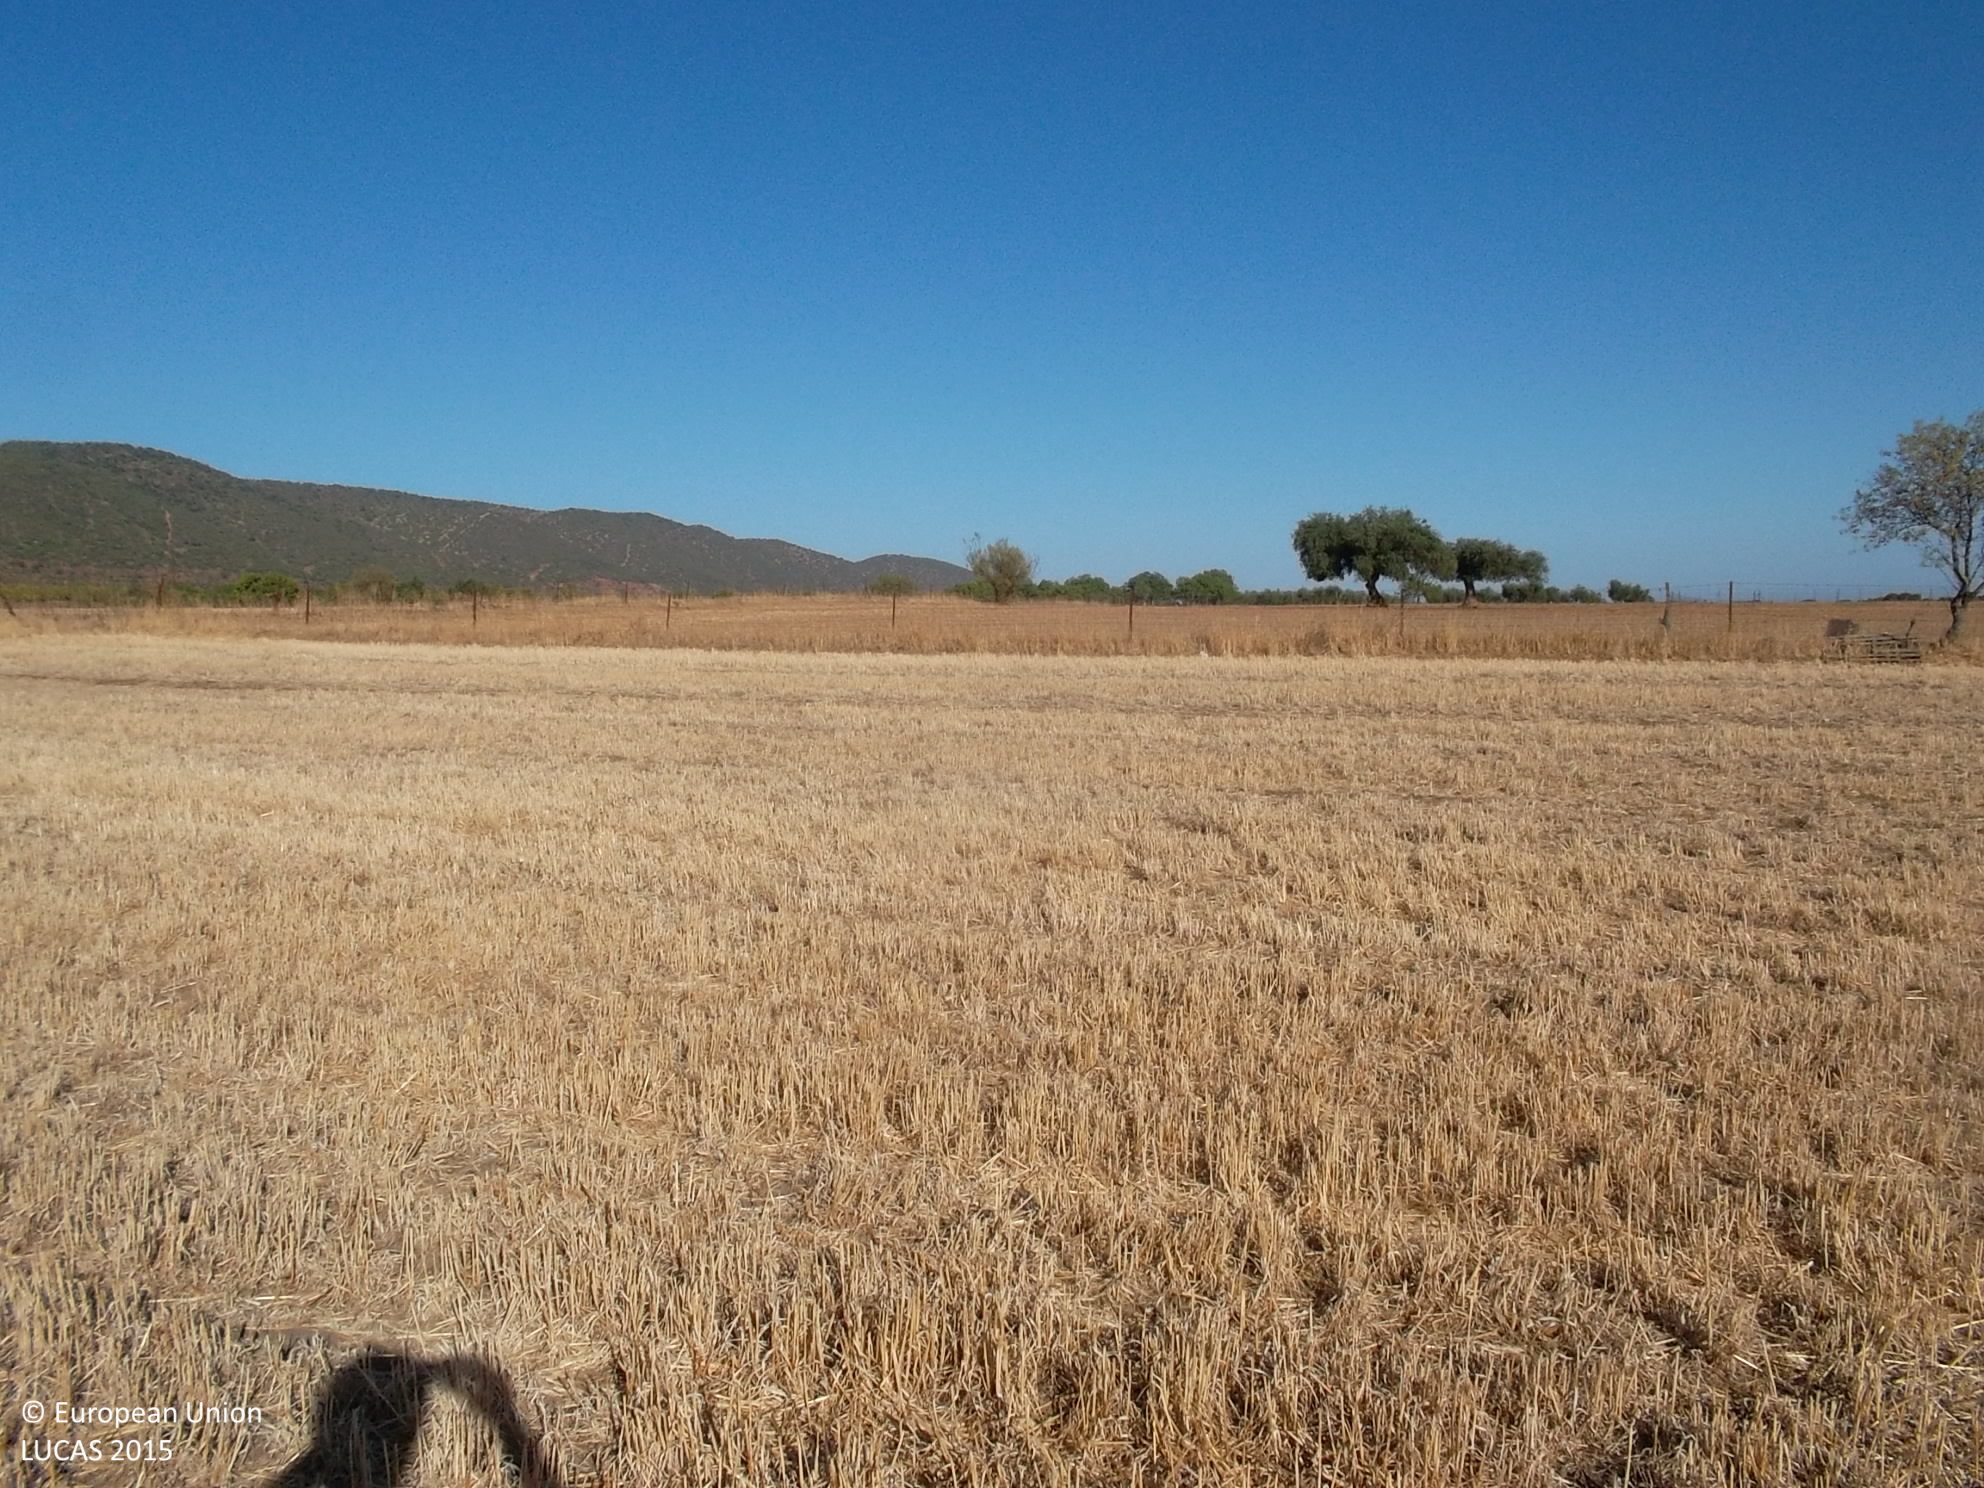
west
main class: Cropland
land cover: Mixed cereals for fodder
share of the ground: < 10 %
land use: Agriculture (excluding fallow land and kitchen gardens)
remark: Harvested field
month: August
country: ES
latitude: 38.5547
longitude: -6.6619
